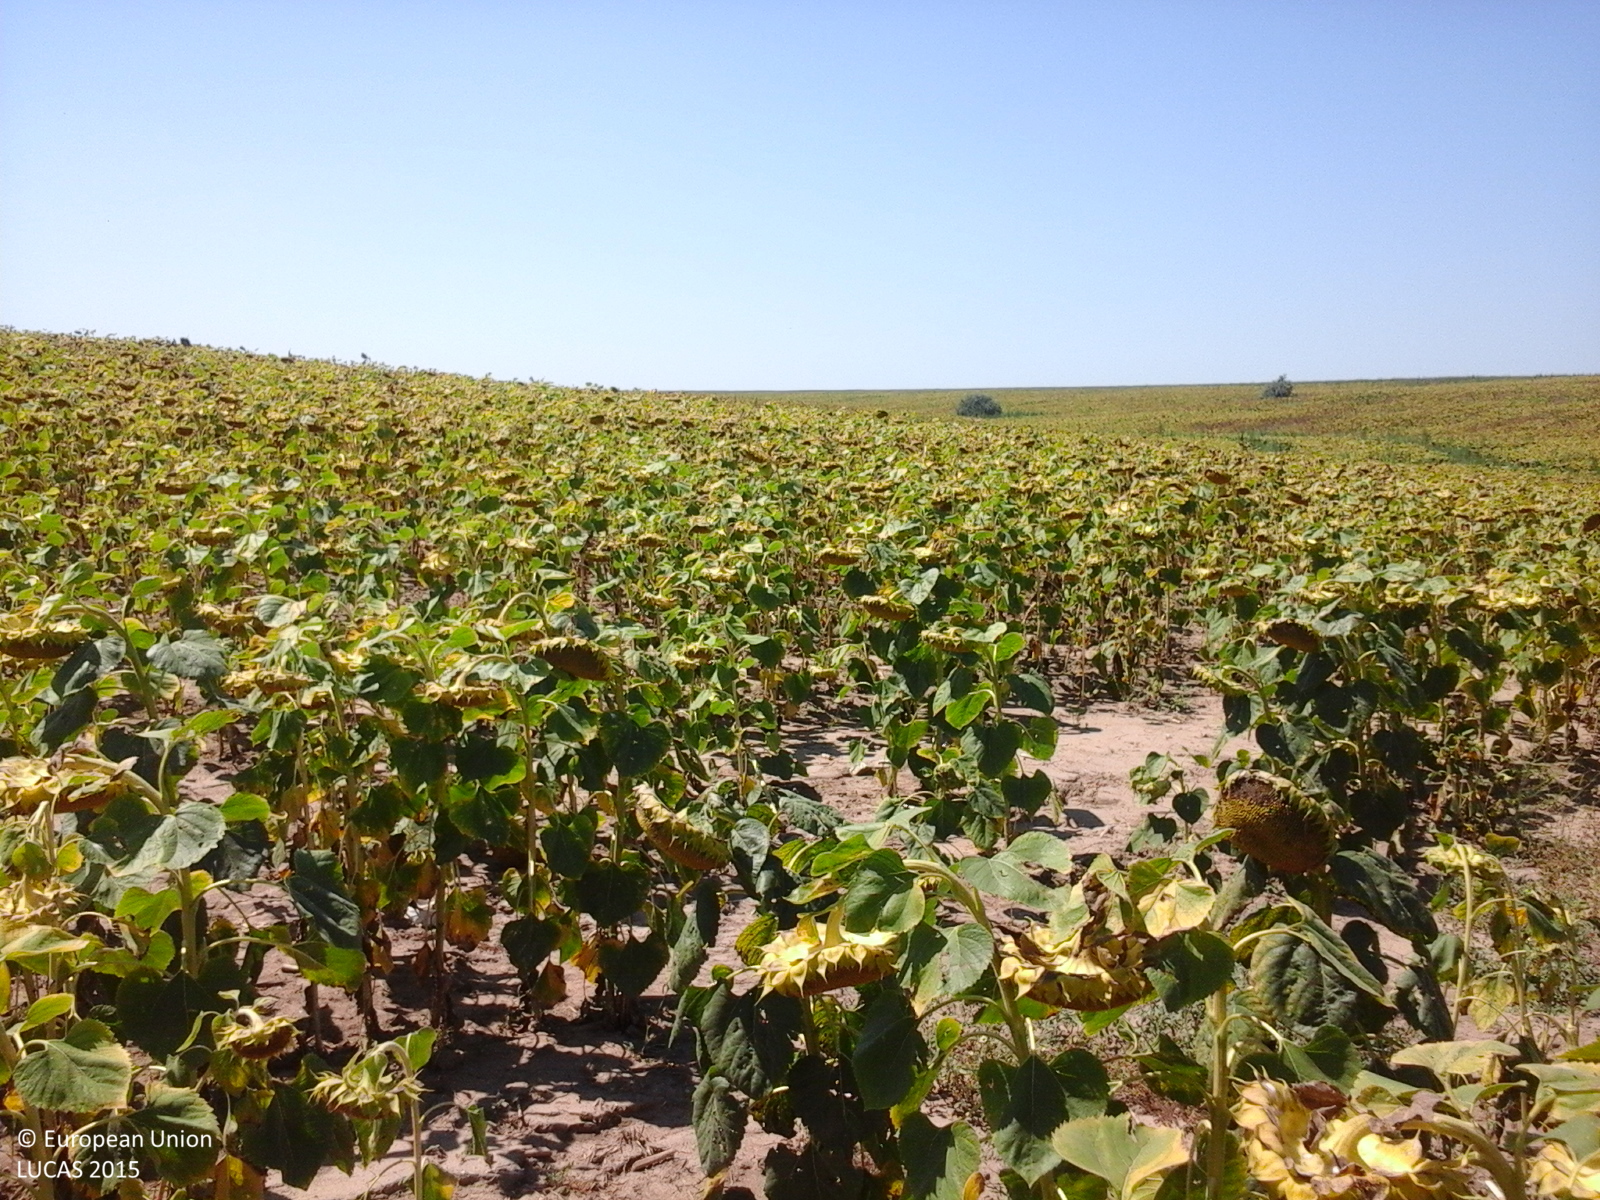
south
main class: Cropland
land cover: Sunflower
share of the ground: > 75 %
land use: Agriculture (excluding fallow land and kitchen gardens)
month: August
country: RO
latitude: 44.6856
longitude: 28.1699
